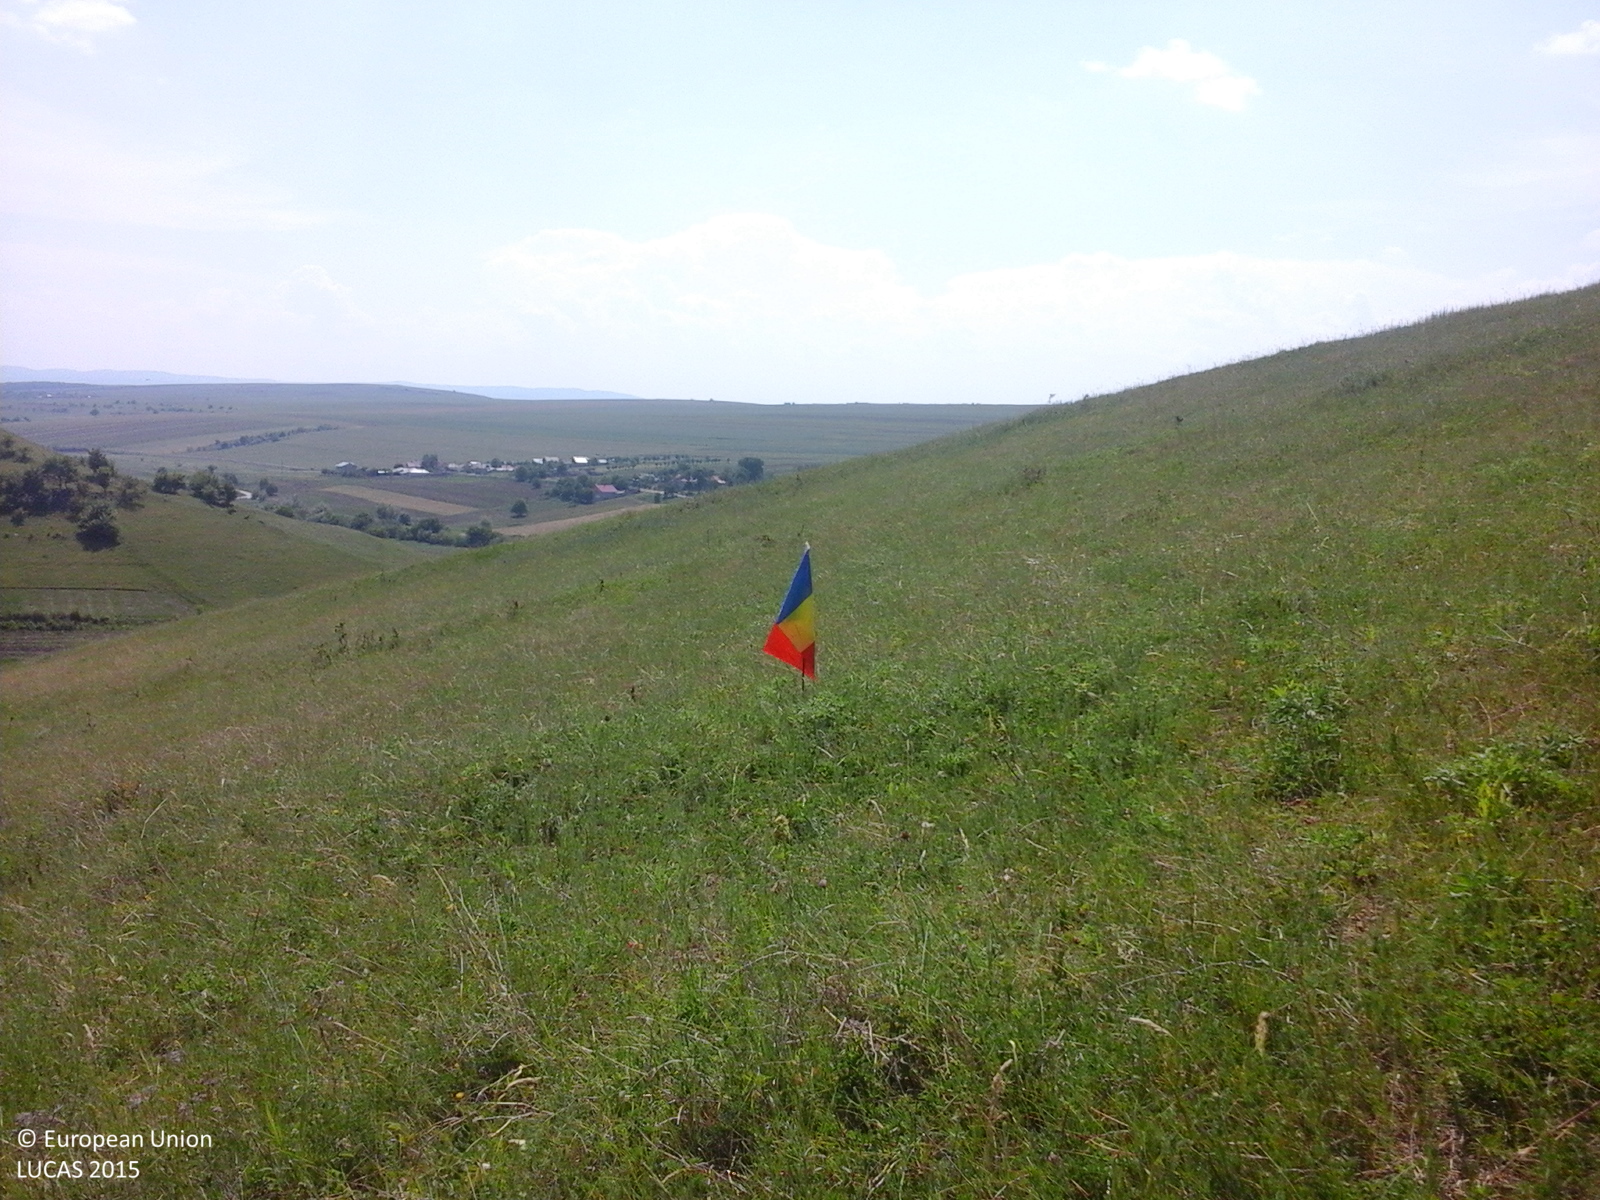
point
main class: Grassland
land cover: Grassland without tree/shrub cover
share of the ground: > 75 %
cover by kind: herbaceous plants 100 %
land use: Agriculture (excluding fallow land and kitchen gardens)
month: June
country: RO
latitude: 46.4273
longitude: 27.1331
